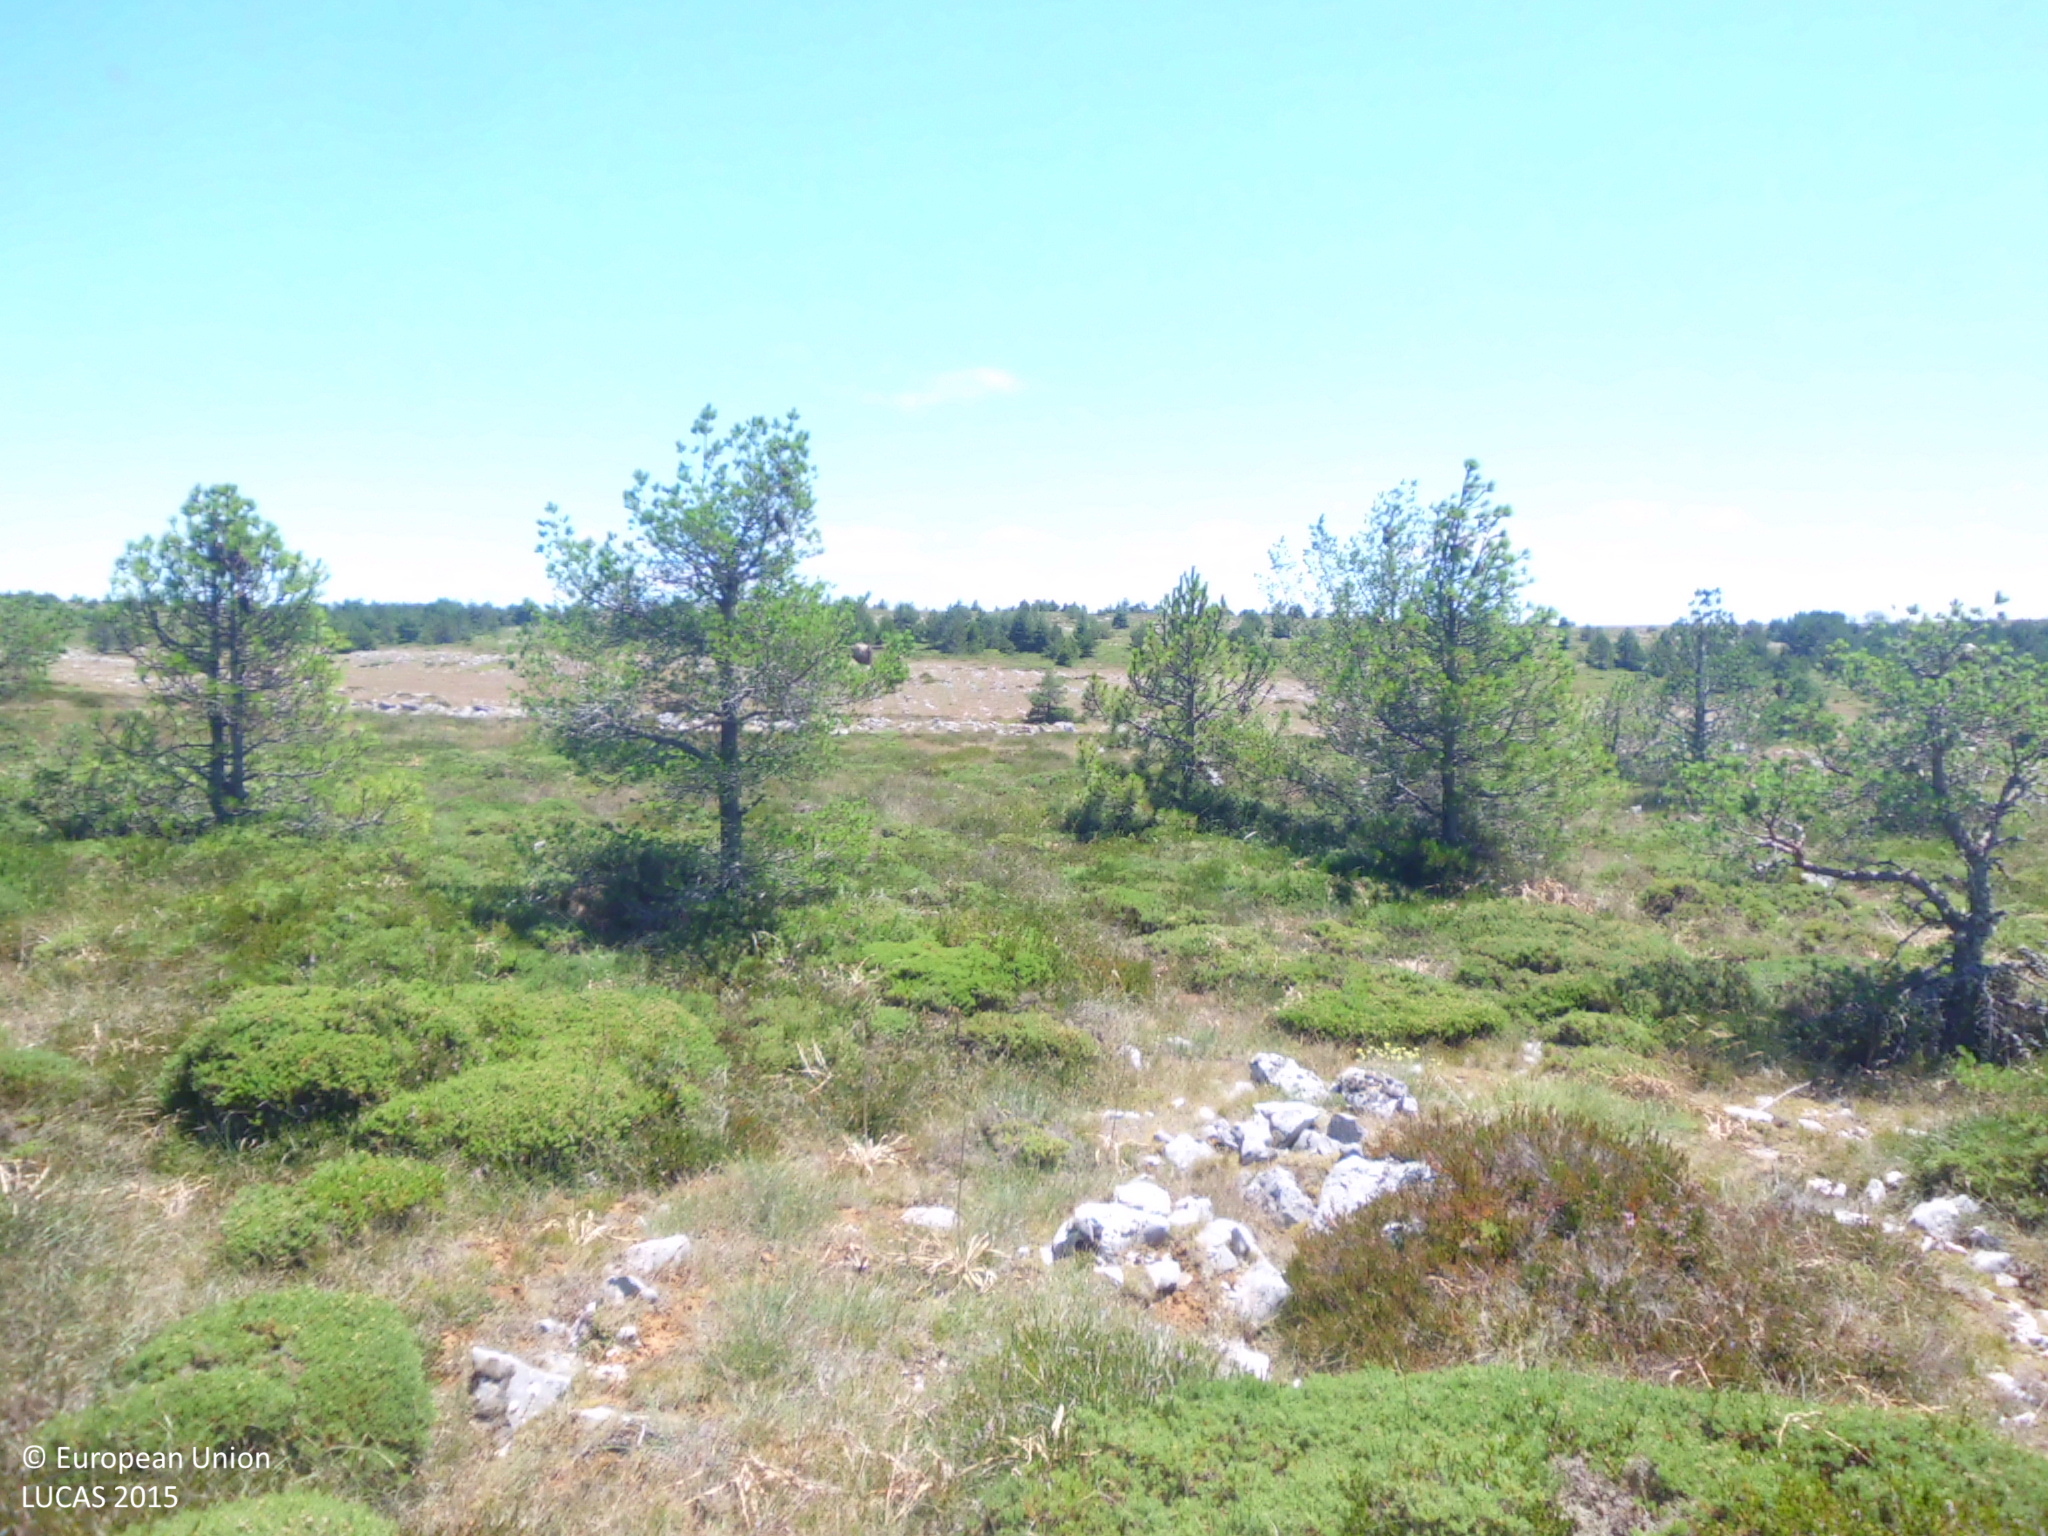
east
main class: Shrubland
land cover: Shrubland with sparse tree cover
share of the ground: 50 - 75 %
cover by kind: shrubs 50 %, consolidated bare surface 25 %, herbaceous plants 20 %, coniferous forest trees 5 %
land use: Semi-natural and natural areas not in use
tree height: < 5 m
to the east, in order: Shrubland with sparse tree cover; Rock outcrops; Shrubland with sparse tree cover
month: July
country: ES
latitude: 42.7763
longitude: -4.1155
